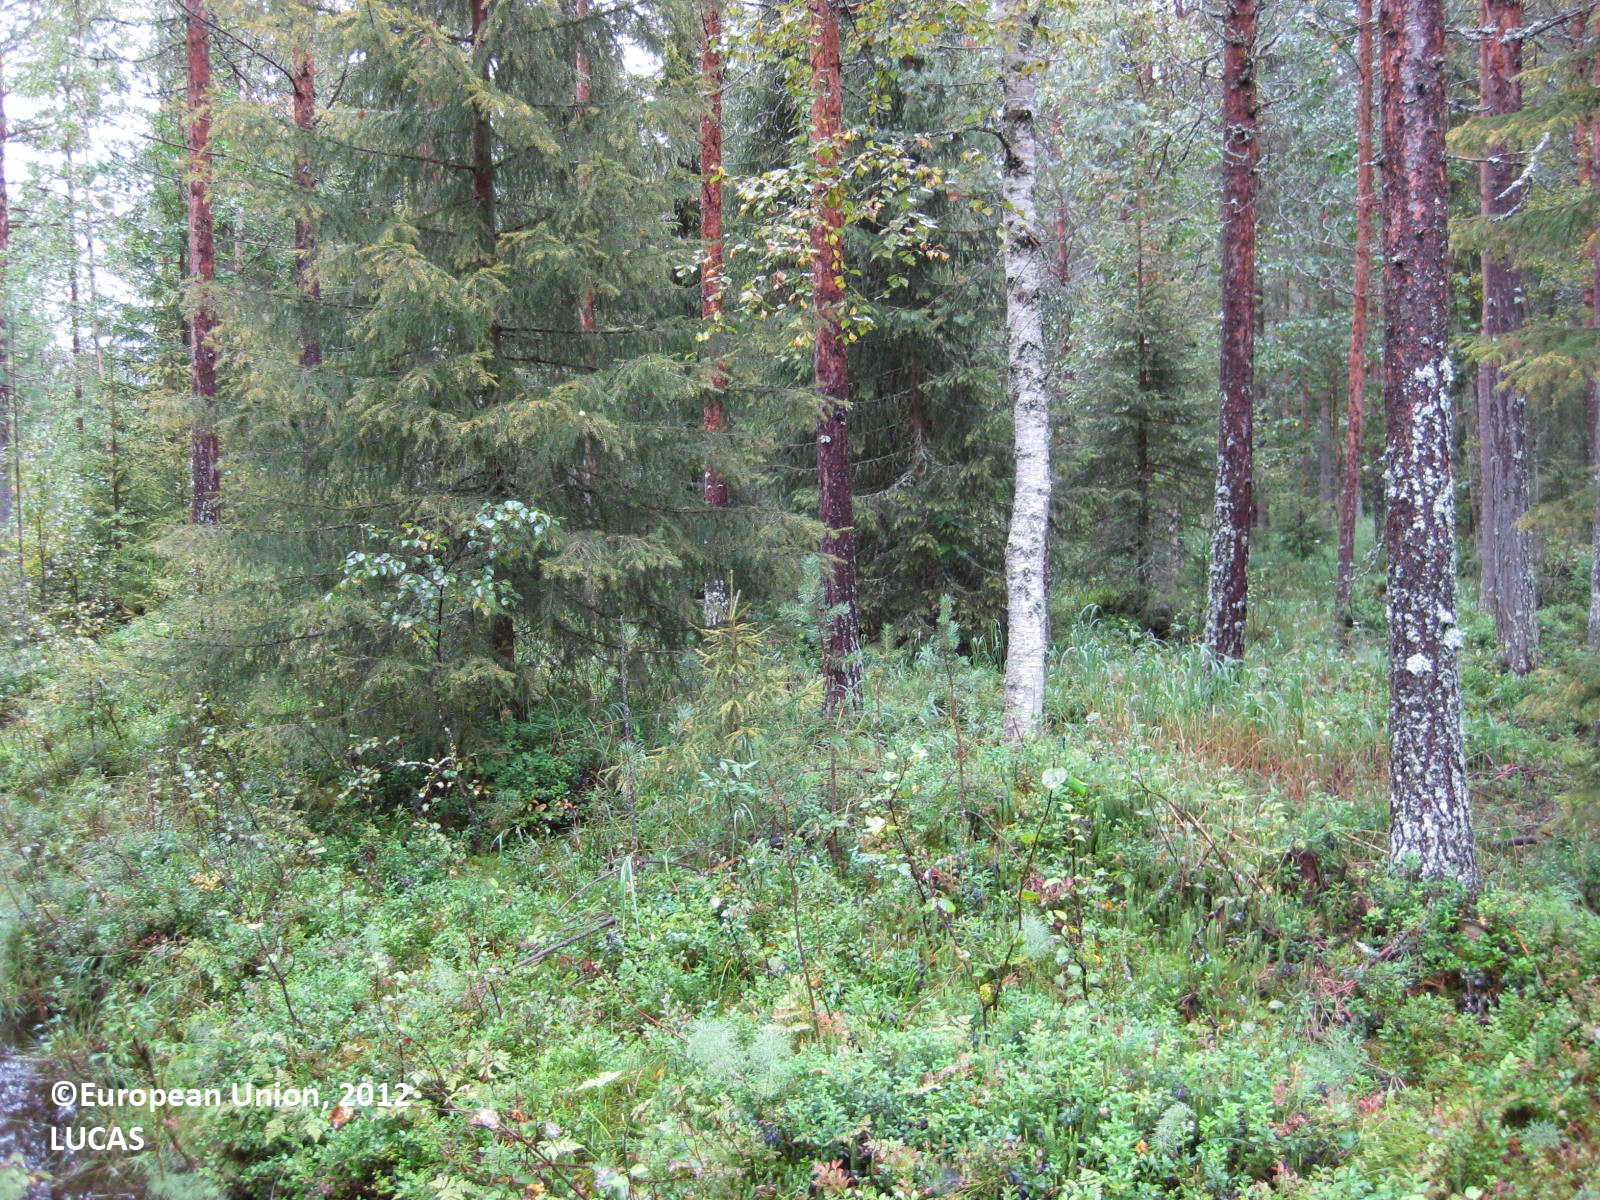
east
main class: Woodland
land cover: Pine dominated mixed woodland
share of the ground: > 75 %
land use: Forestry
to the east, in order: Pine dominated mixed woodland; Ditches and canals; Pine dominated coniferous woodland; Ditches and canals; Pine dominated coniferous woodland; Grass margins; Ditches and canals; Grass margins; Spruce dominated coniferous woodland; Rivers and streams; Pine dominated coniferous woodland; Other mixed woodland; Ditches and canals; Other coniferous woodland; Rivers and streams; Spruce dominated mixed woodland; Pine dominated mixed woodland; Ditches and canals; Pine dominated mixed woodland; Ditches and canals; Pine dominated mixed woodland; Ditches and canals; Pine dominated mixed woodland; Ditches and canals; Pine dominated mixed woodland
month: August
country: FI
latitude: 66.1408
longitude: 28.7946
